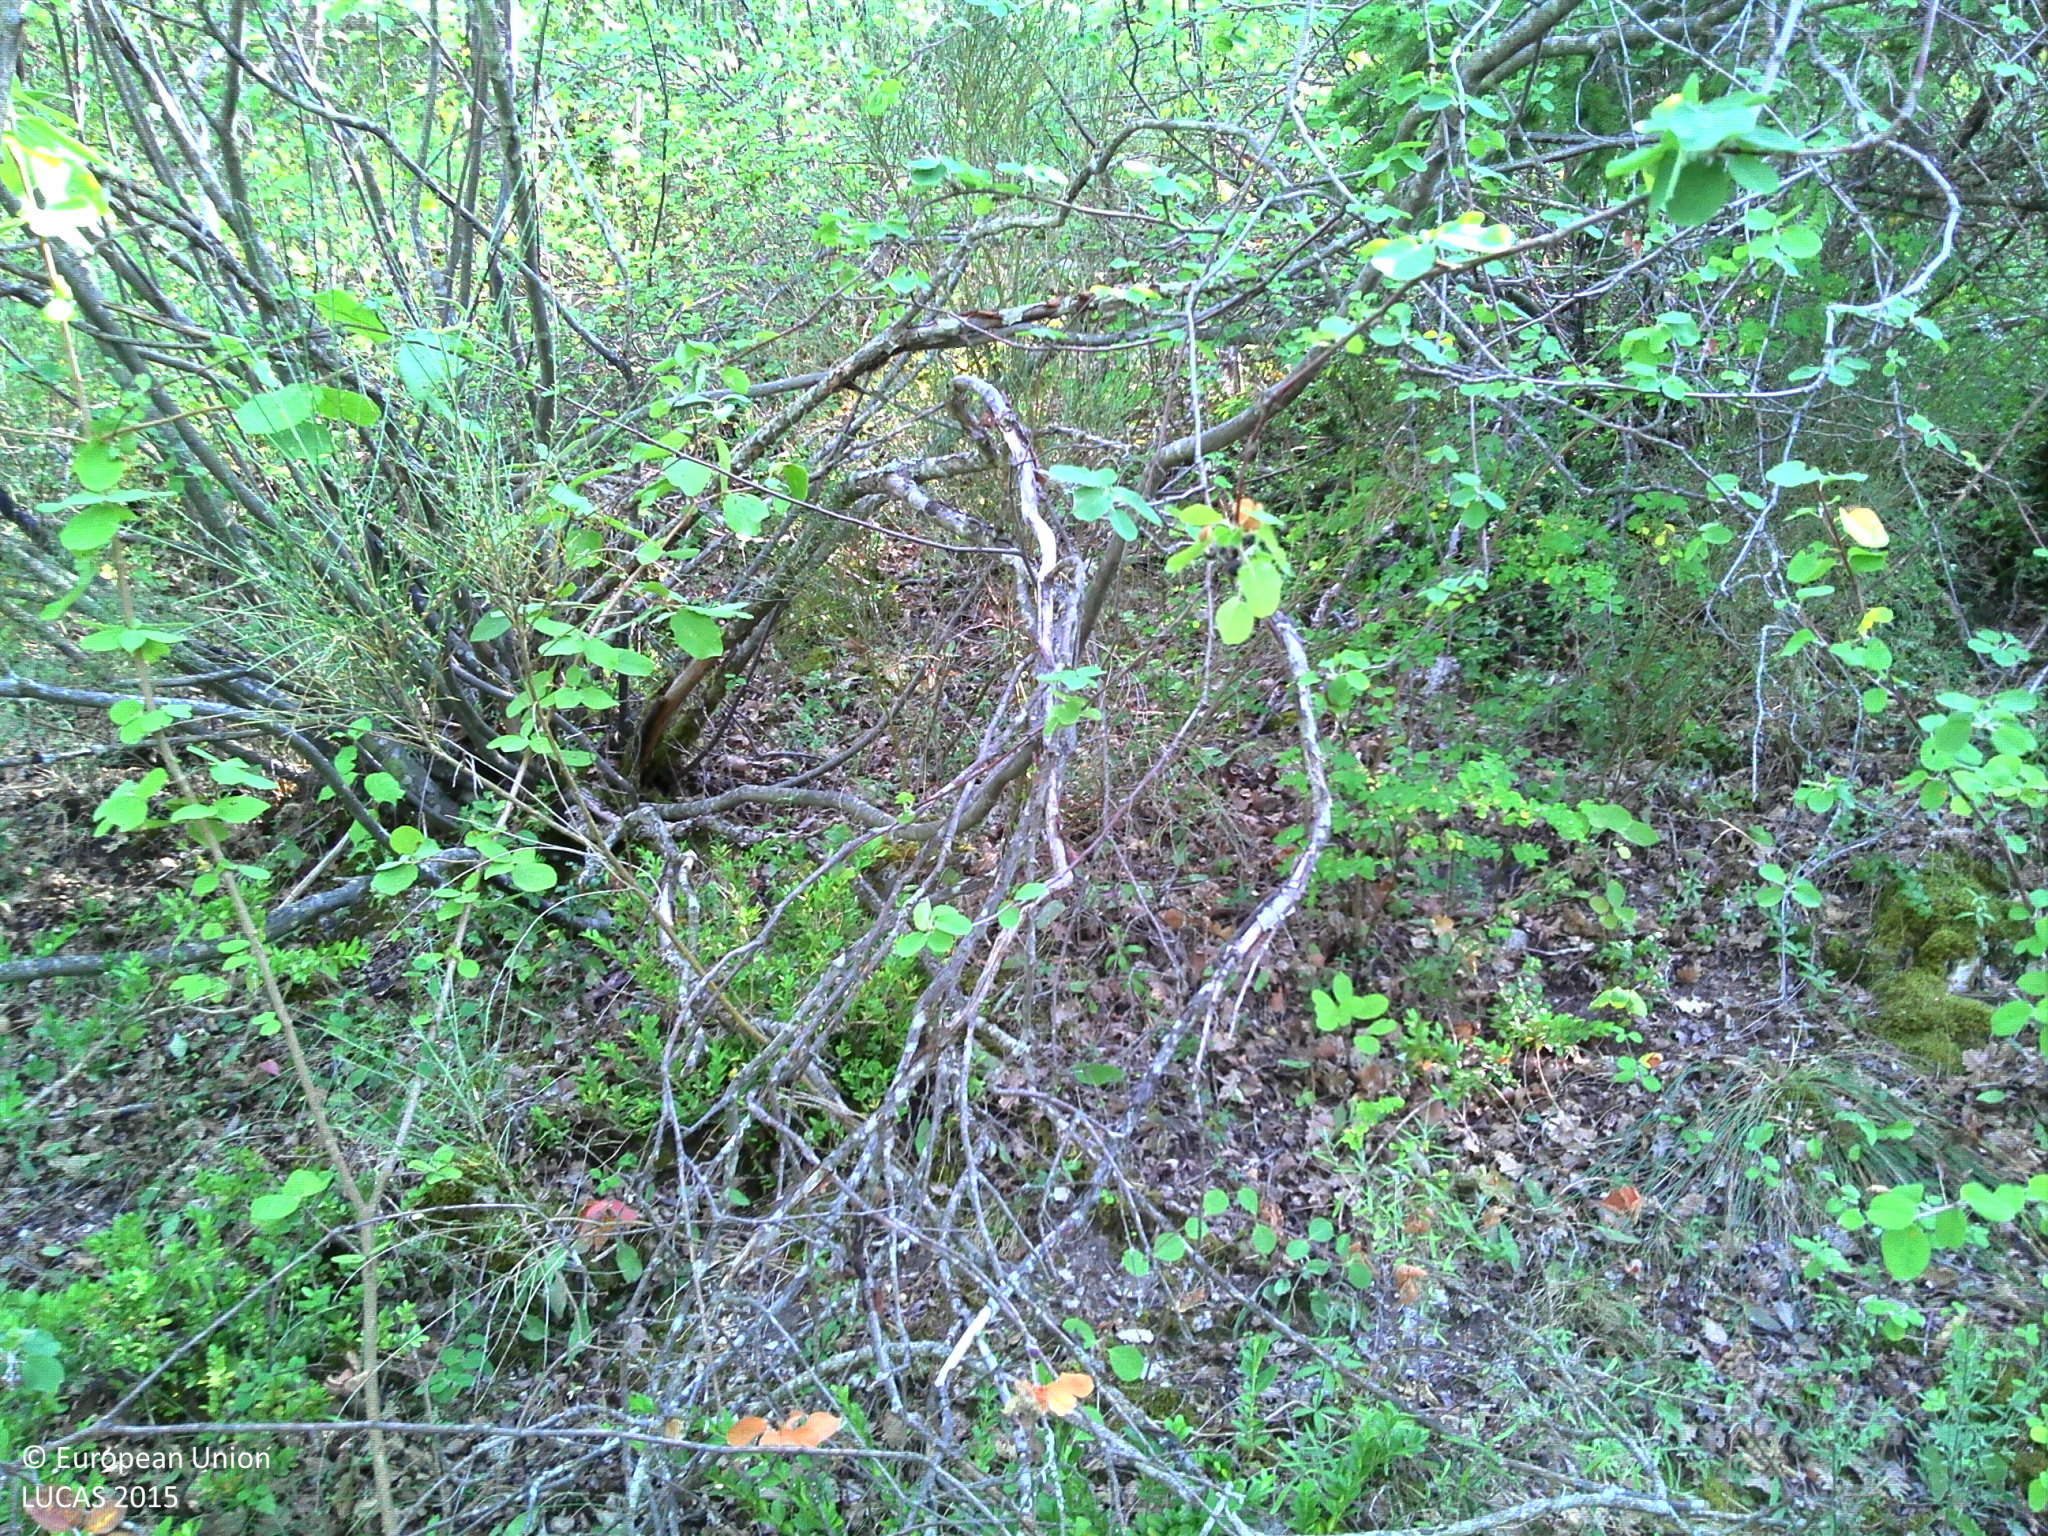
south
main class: Woodland
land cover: Broadleaved woodland
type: broadleaved evergreen forest
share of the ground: > 75 %
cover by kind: broadleaved forest trees 75 %, shrubs 15 %, herbaceous plants 5 %, unconsolidated bare surface 5 %
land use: Semi-natural and natural areas not in use
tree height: < 5 m
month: August
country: FR
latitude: 43.8497
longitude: 5.3688
